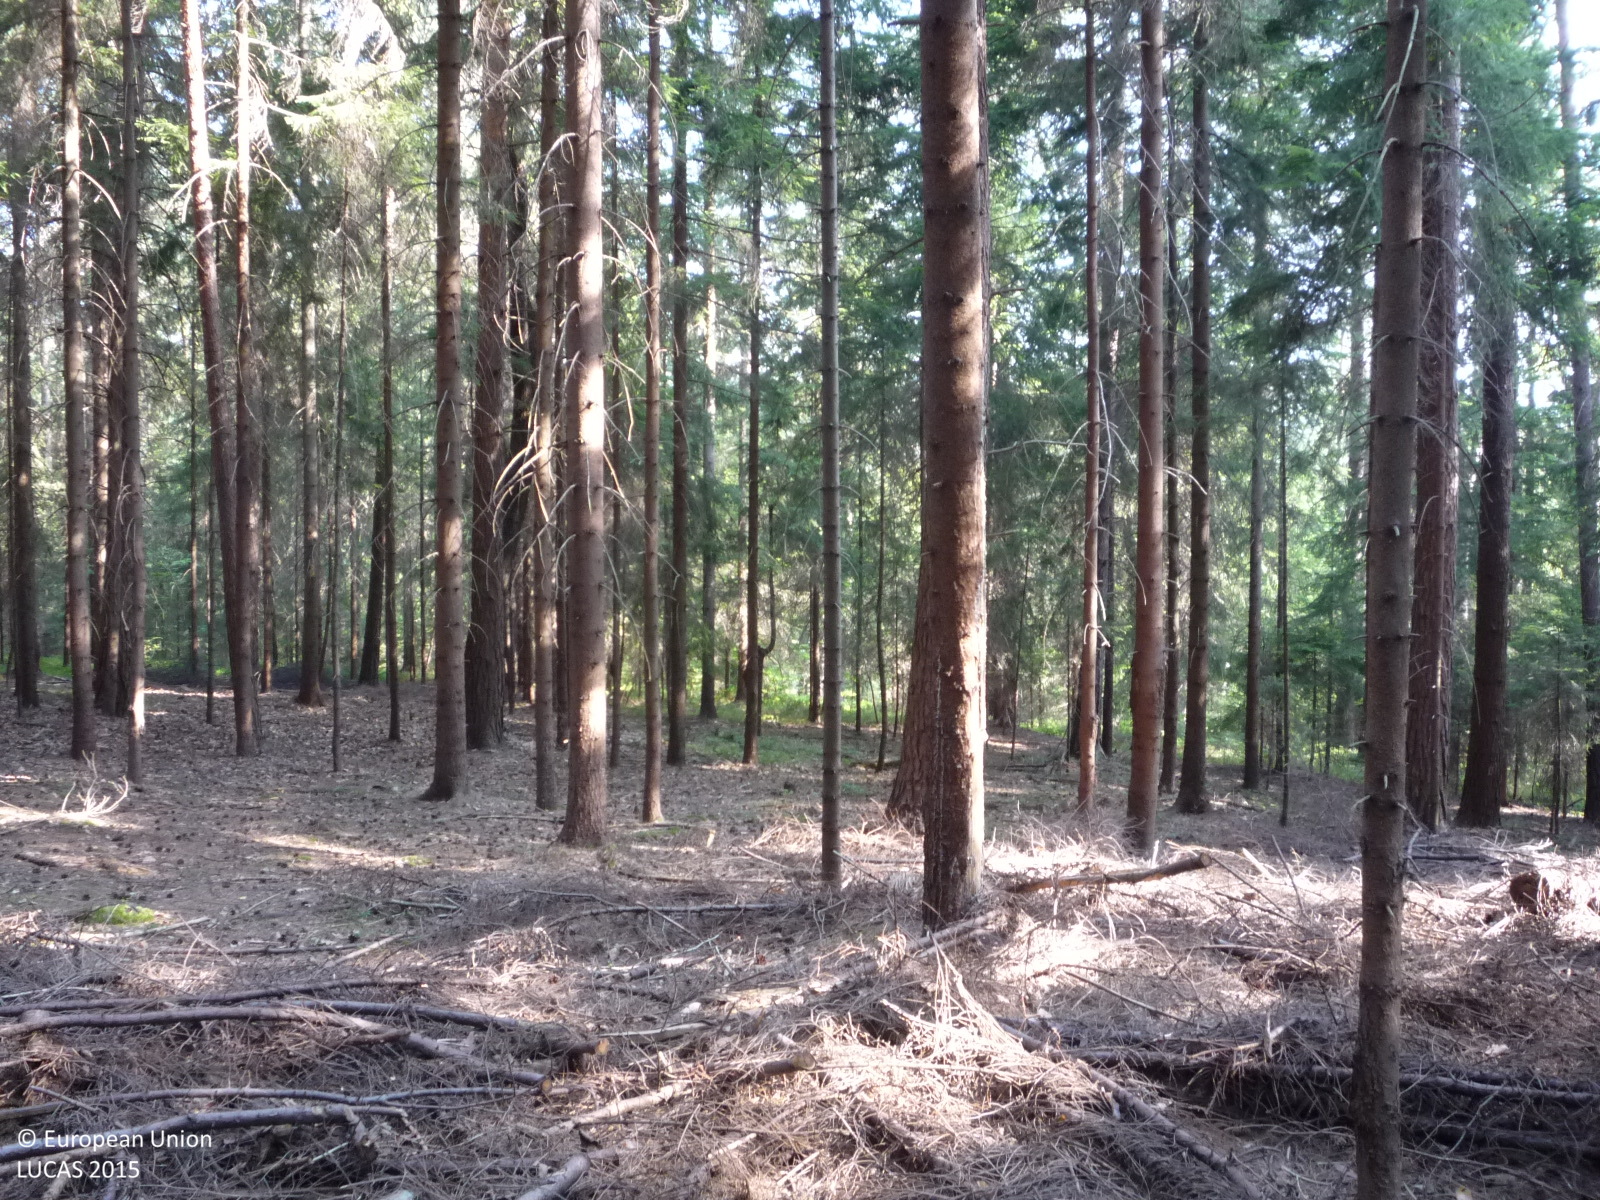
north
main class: Woodland
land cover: Spruce dominated coniferous woodland
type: hemiboreal forest and nemoral coniferous forest and mixed broadleaved-coniferous forest
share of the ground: > 75 %
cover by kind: coniferous forest trees 90 %, shrubs 5 %, unconsolidated bare surface 5 %
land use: Forestry
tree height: > 5 m
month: August
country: CZ
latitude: 50.6938
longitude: 15.2556
